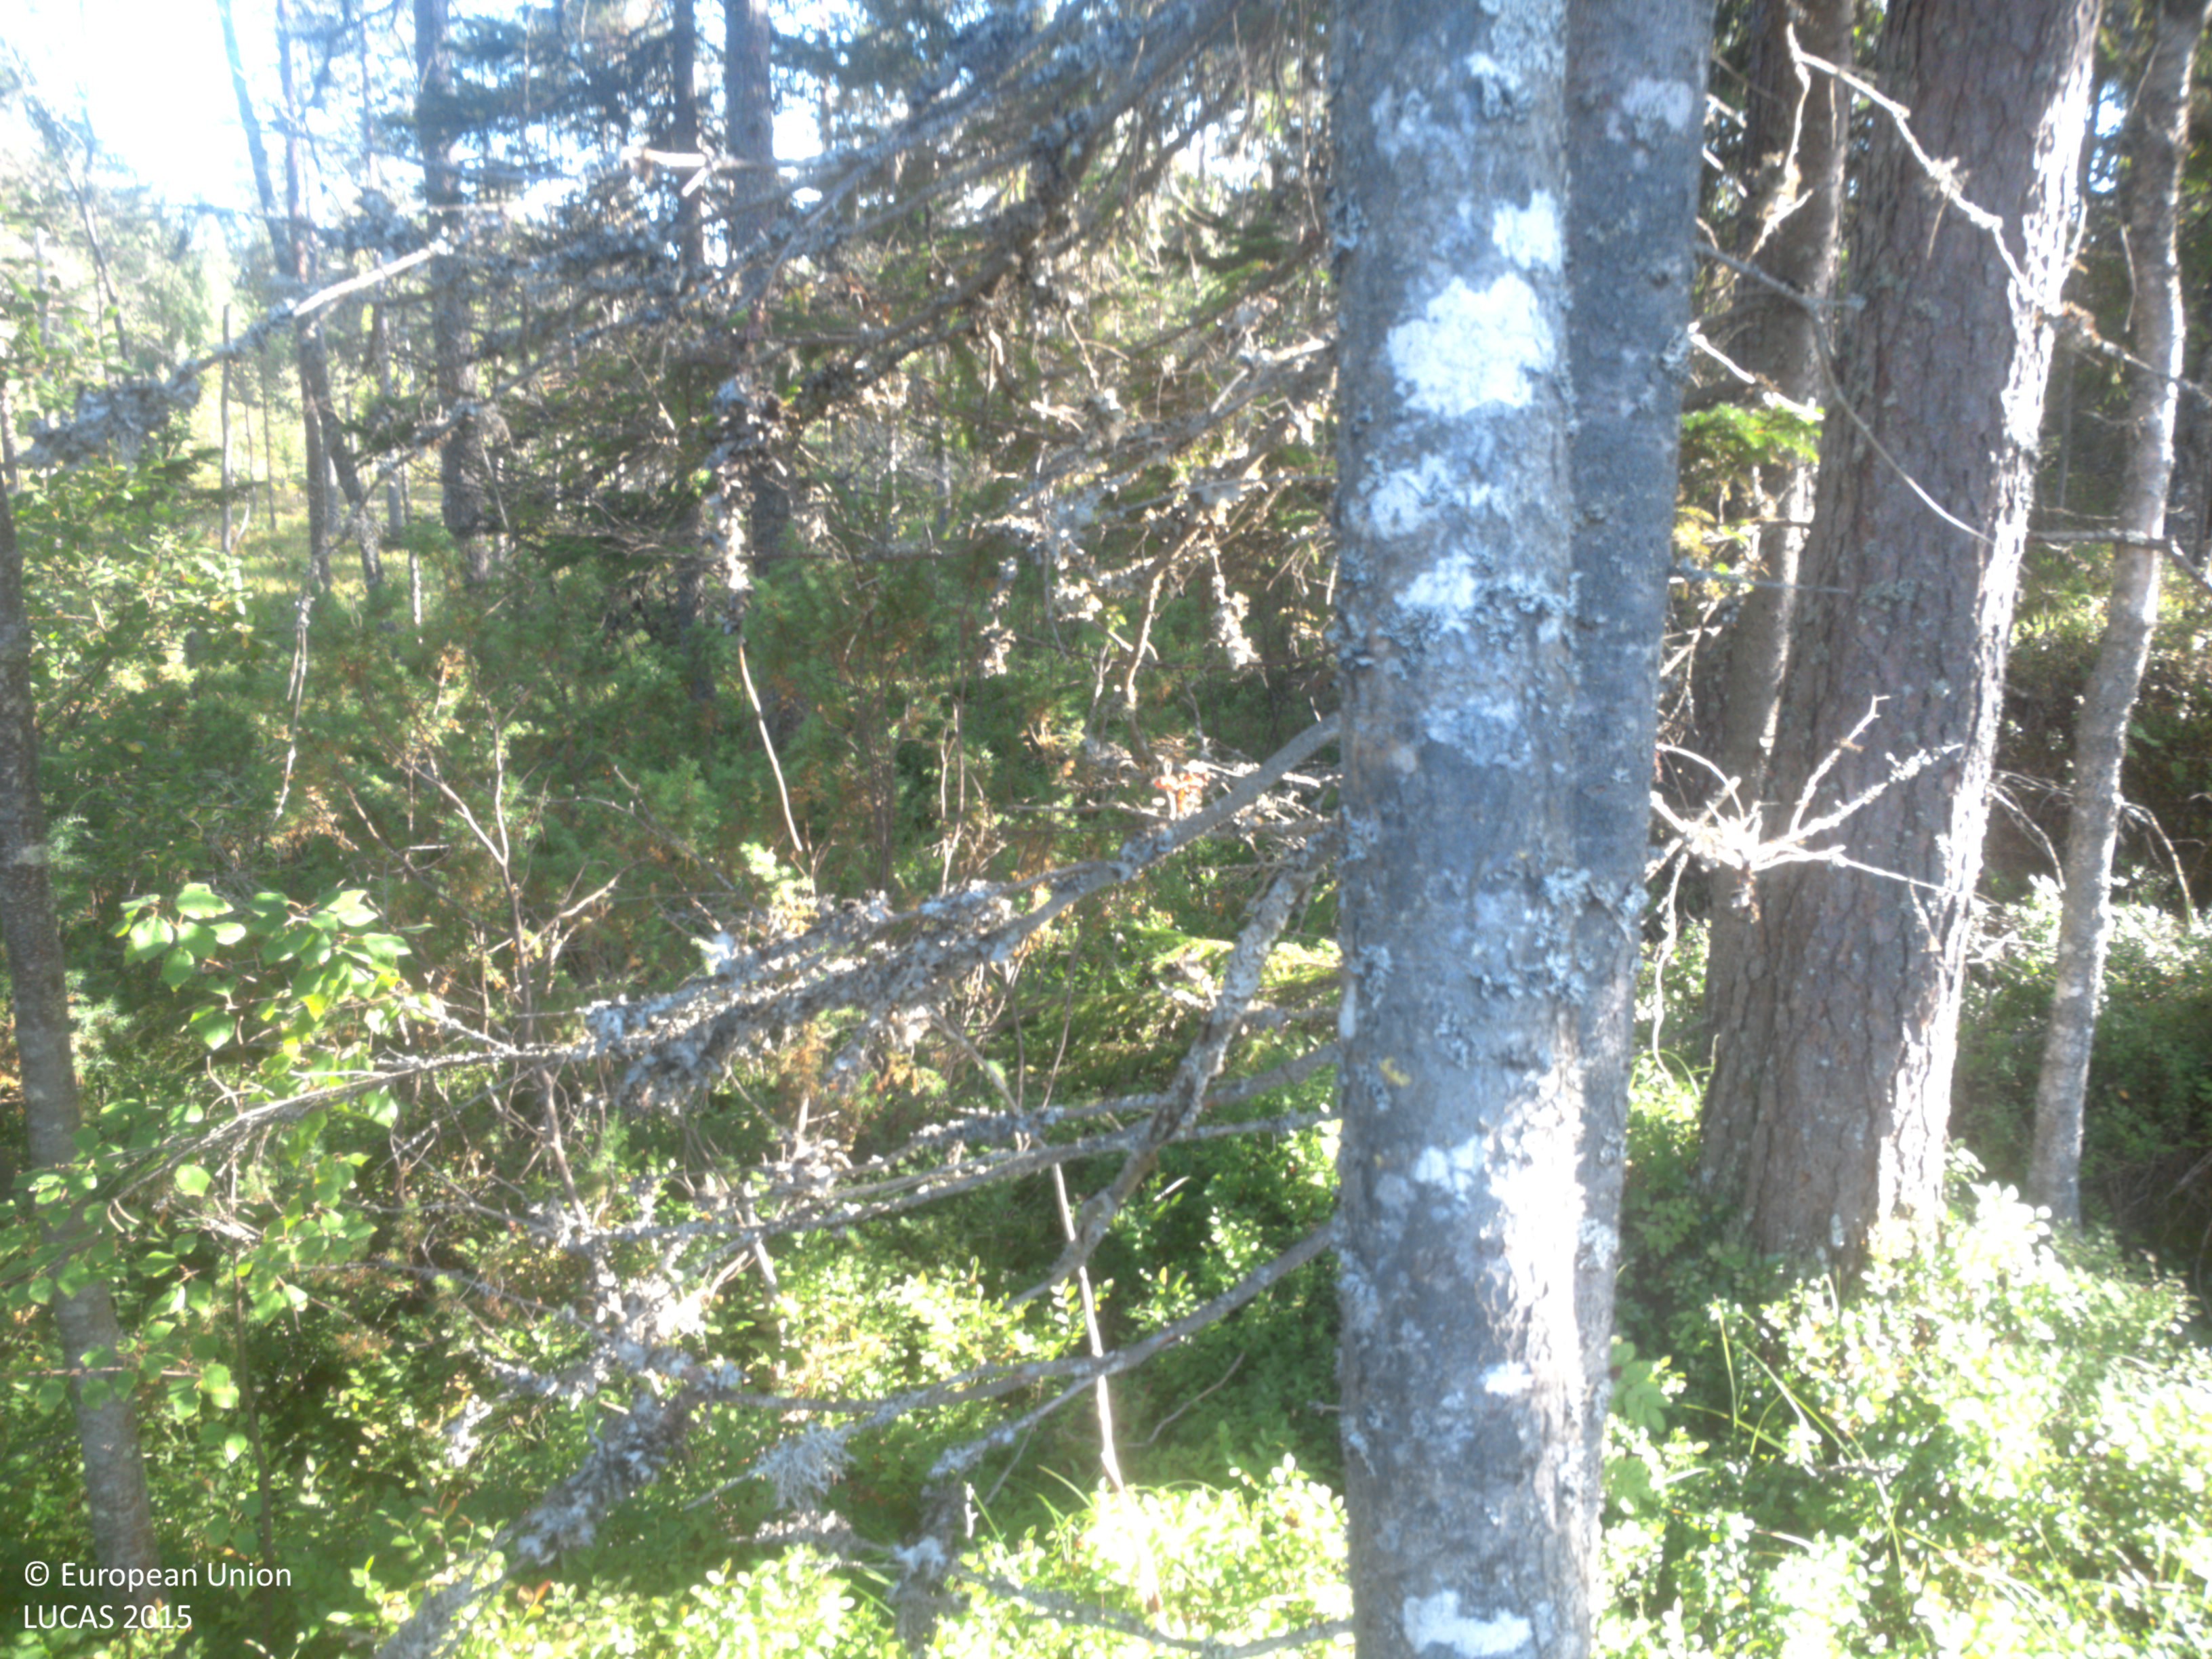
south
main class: Woodland
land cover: Other coniferous woodland
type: boreal forest
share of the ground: 50 - 75 %
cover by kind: coniferous forest trees 50 %, shrubs 50 %
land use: Forestry
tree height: > 5 m
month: August
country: SE
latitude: 63.7886
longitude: 20.0255
